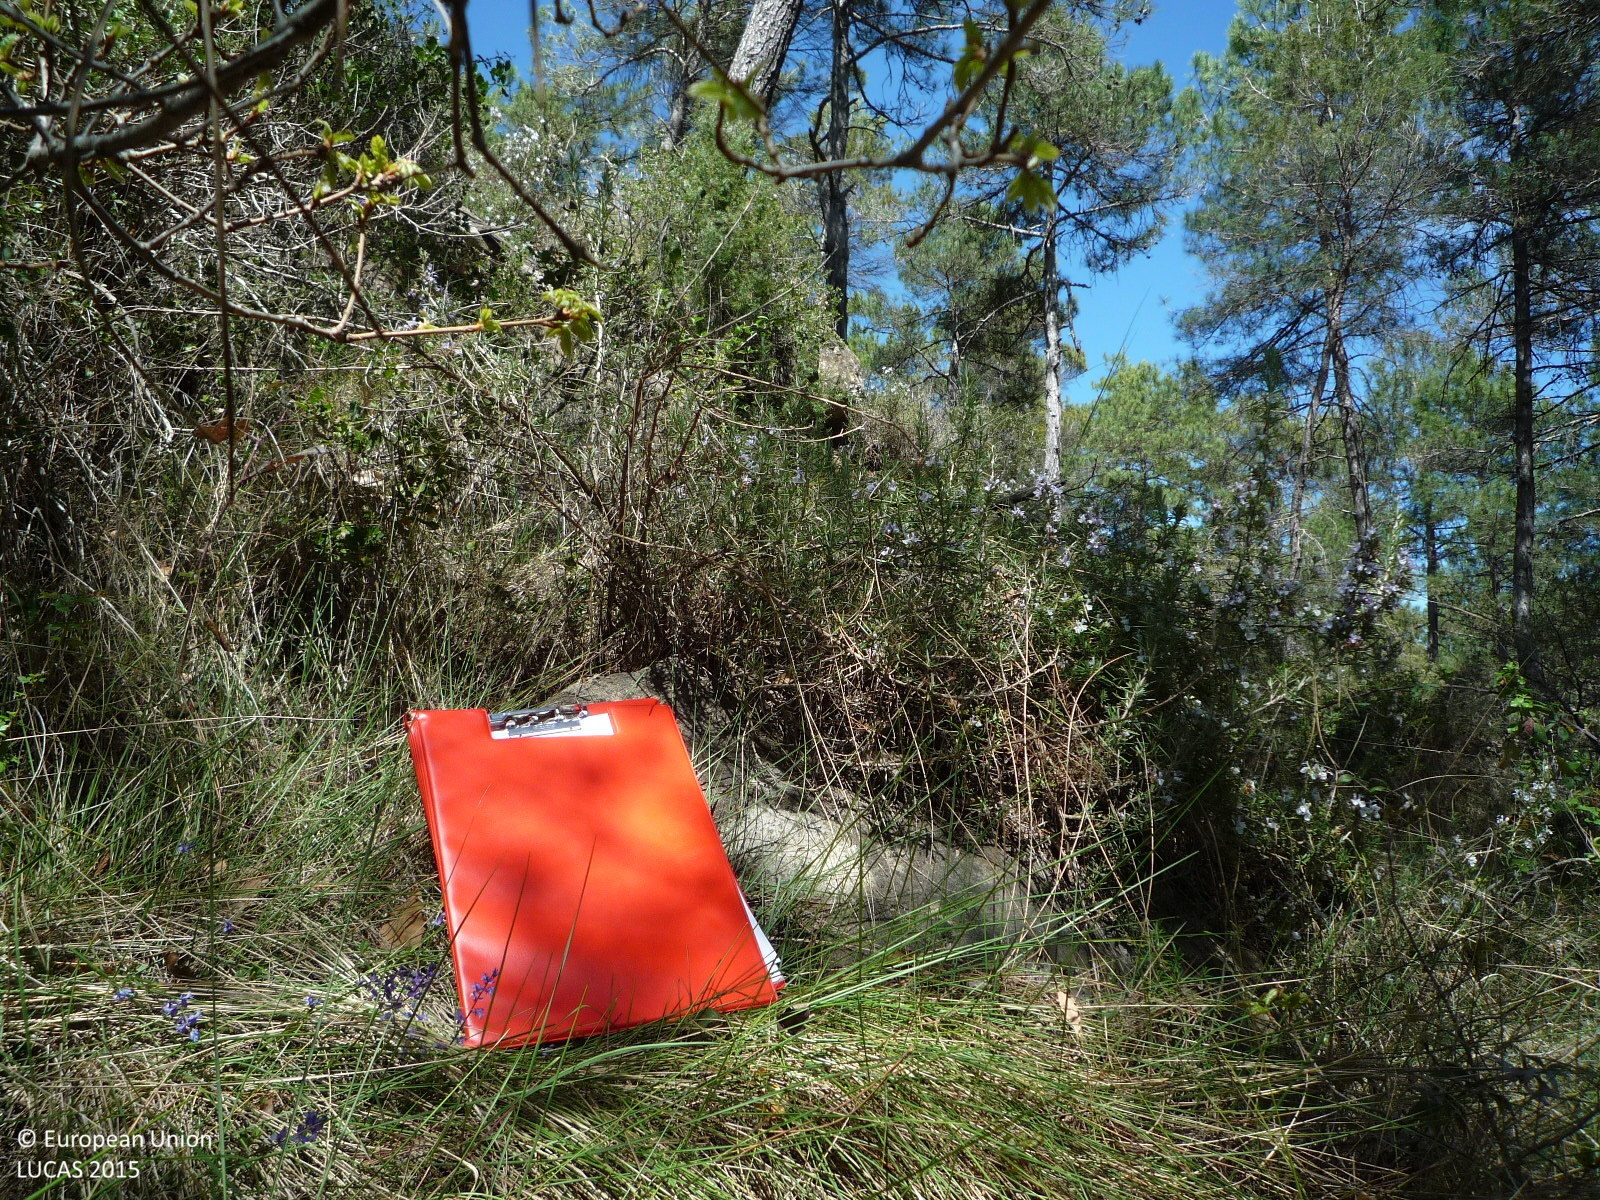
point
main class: Woodland
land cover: Pine dominated coniferous woodland
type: coniferous forest of the mediterranean region
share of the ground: > 75 %
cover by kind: coniferous forest trees 70 %, shrubs 20 %, herbaceous plants 10 %
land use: Forestry
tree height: > 5 m
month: April
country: ES
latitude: 41.7047
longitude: 1.5905
